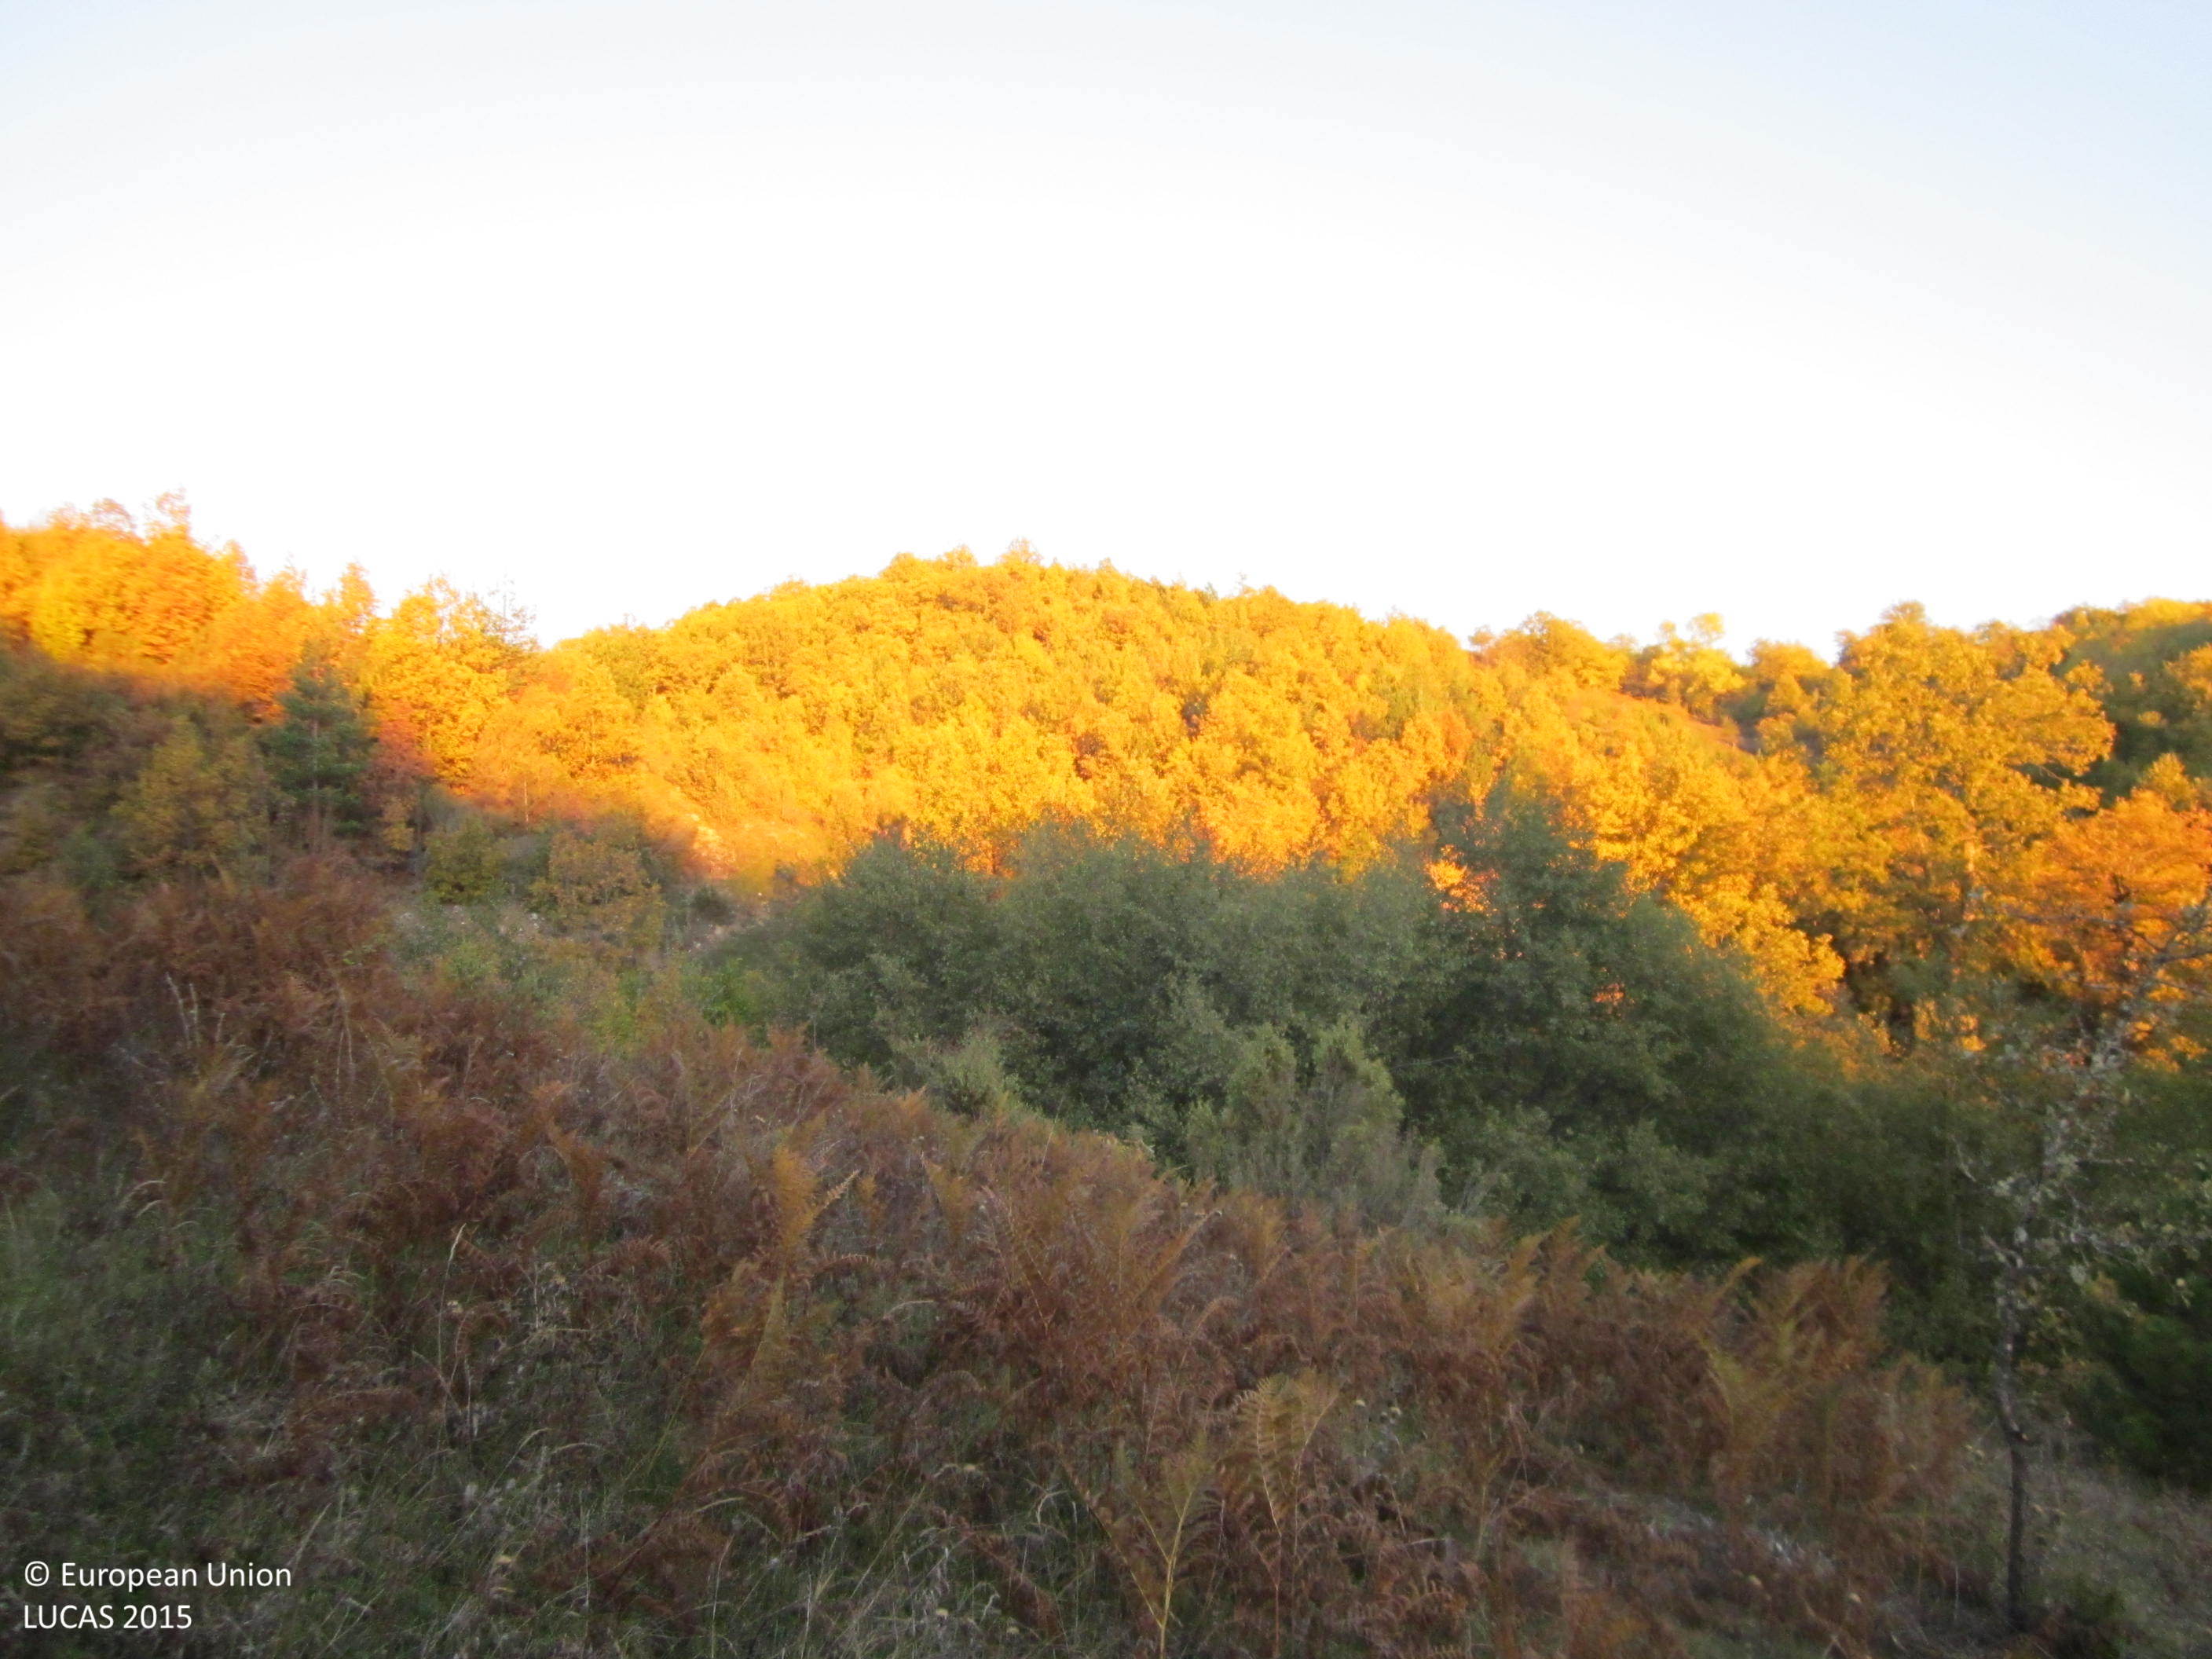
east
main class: Grassland
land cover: Grassland with sparse tree/shrub cover
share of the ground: > 75 %
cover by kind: herbaceous plants 85 %, shrubs 10 %, broadleaved forest trees 5 %
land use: Agriculture (excluding fallow land and kitchen gardens)
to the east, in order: Grassland with sparse tree/shrub cover; Broadleaved woodland; Rivers and streams; Broadleaved woodland
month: November
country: BG
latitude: 41.3782
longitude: 25.7364
